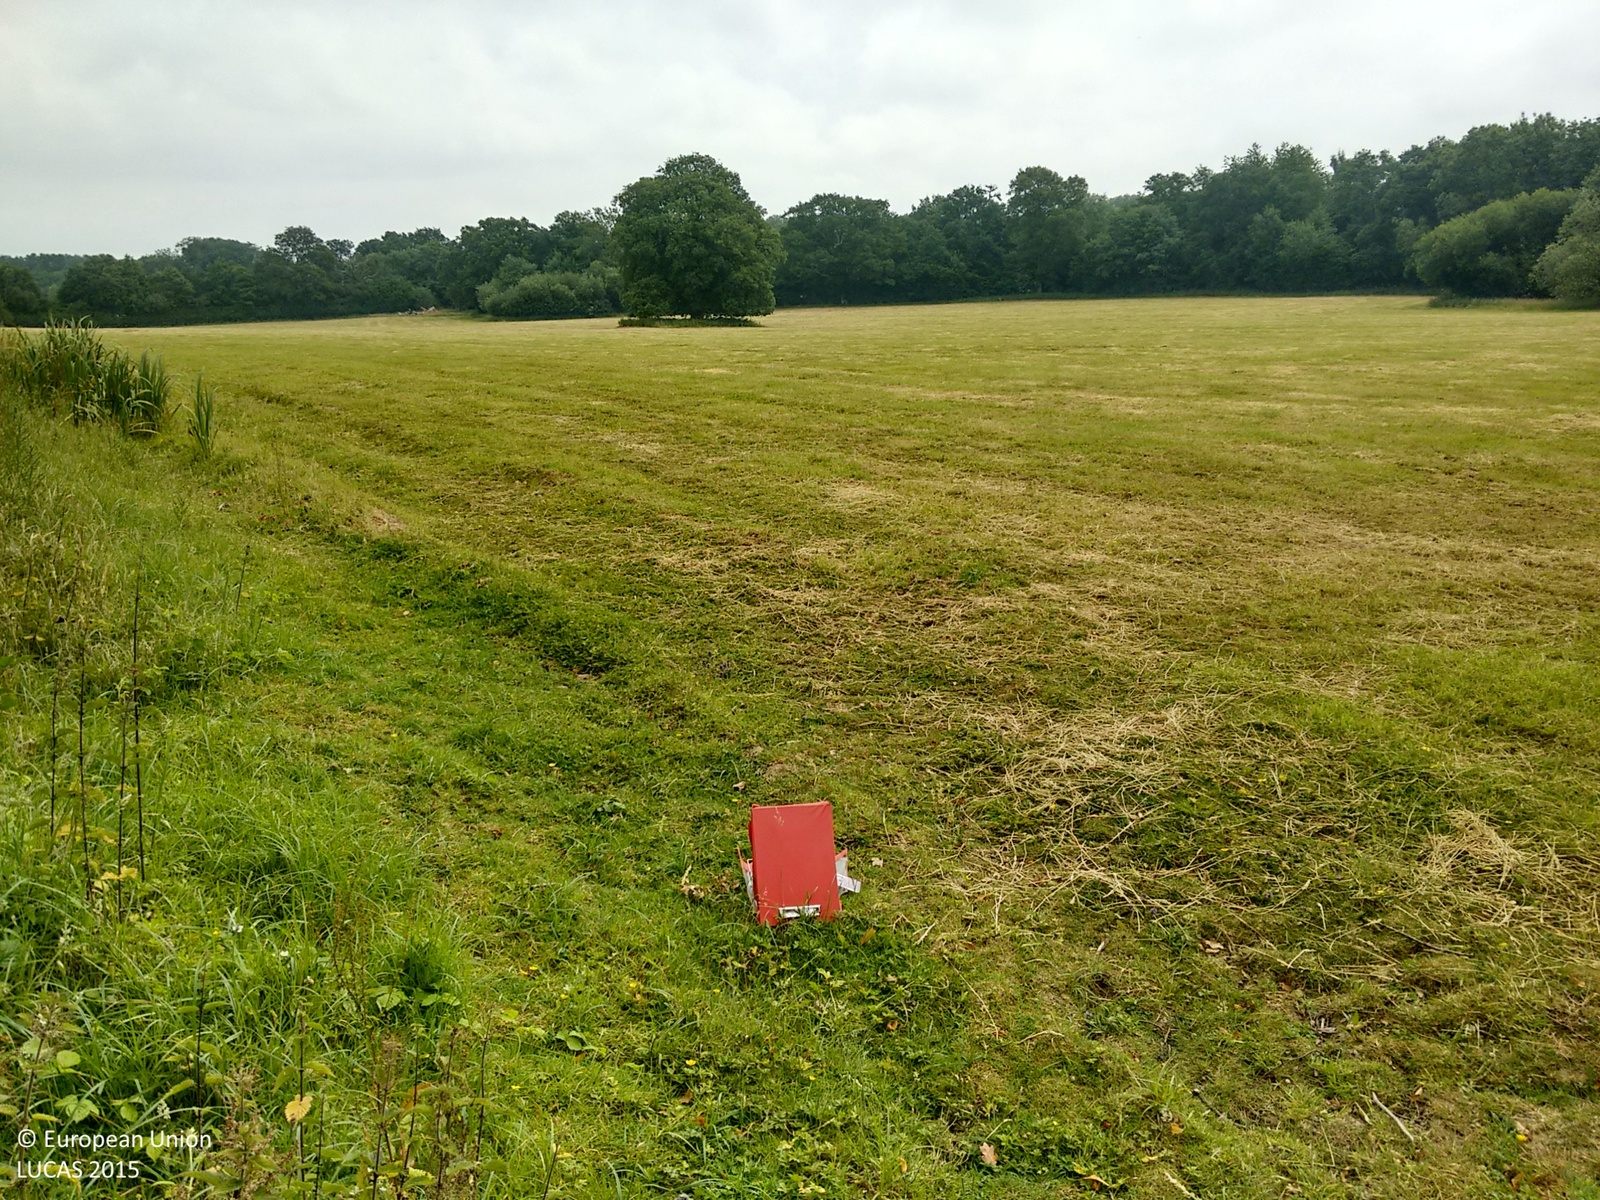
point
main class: Grassland
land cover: Grassland without tree/shrub cover
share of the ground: > 75 %
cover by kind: herbaceous plants 100 %
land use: Agriculture (excluding fallow land and kitchen gardens)
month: July
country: GB
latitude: 51.0331
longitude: -0.1734
